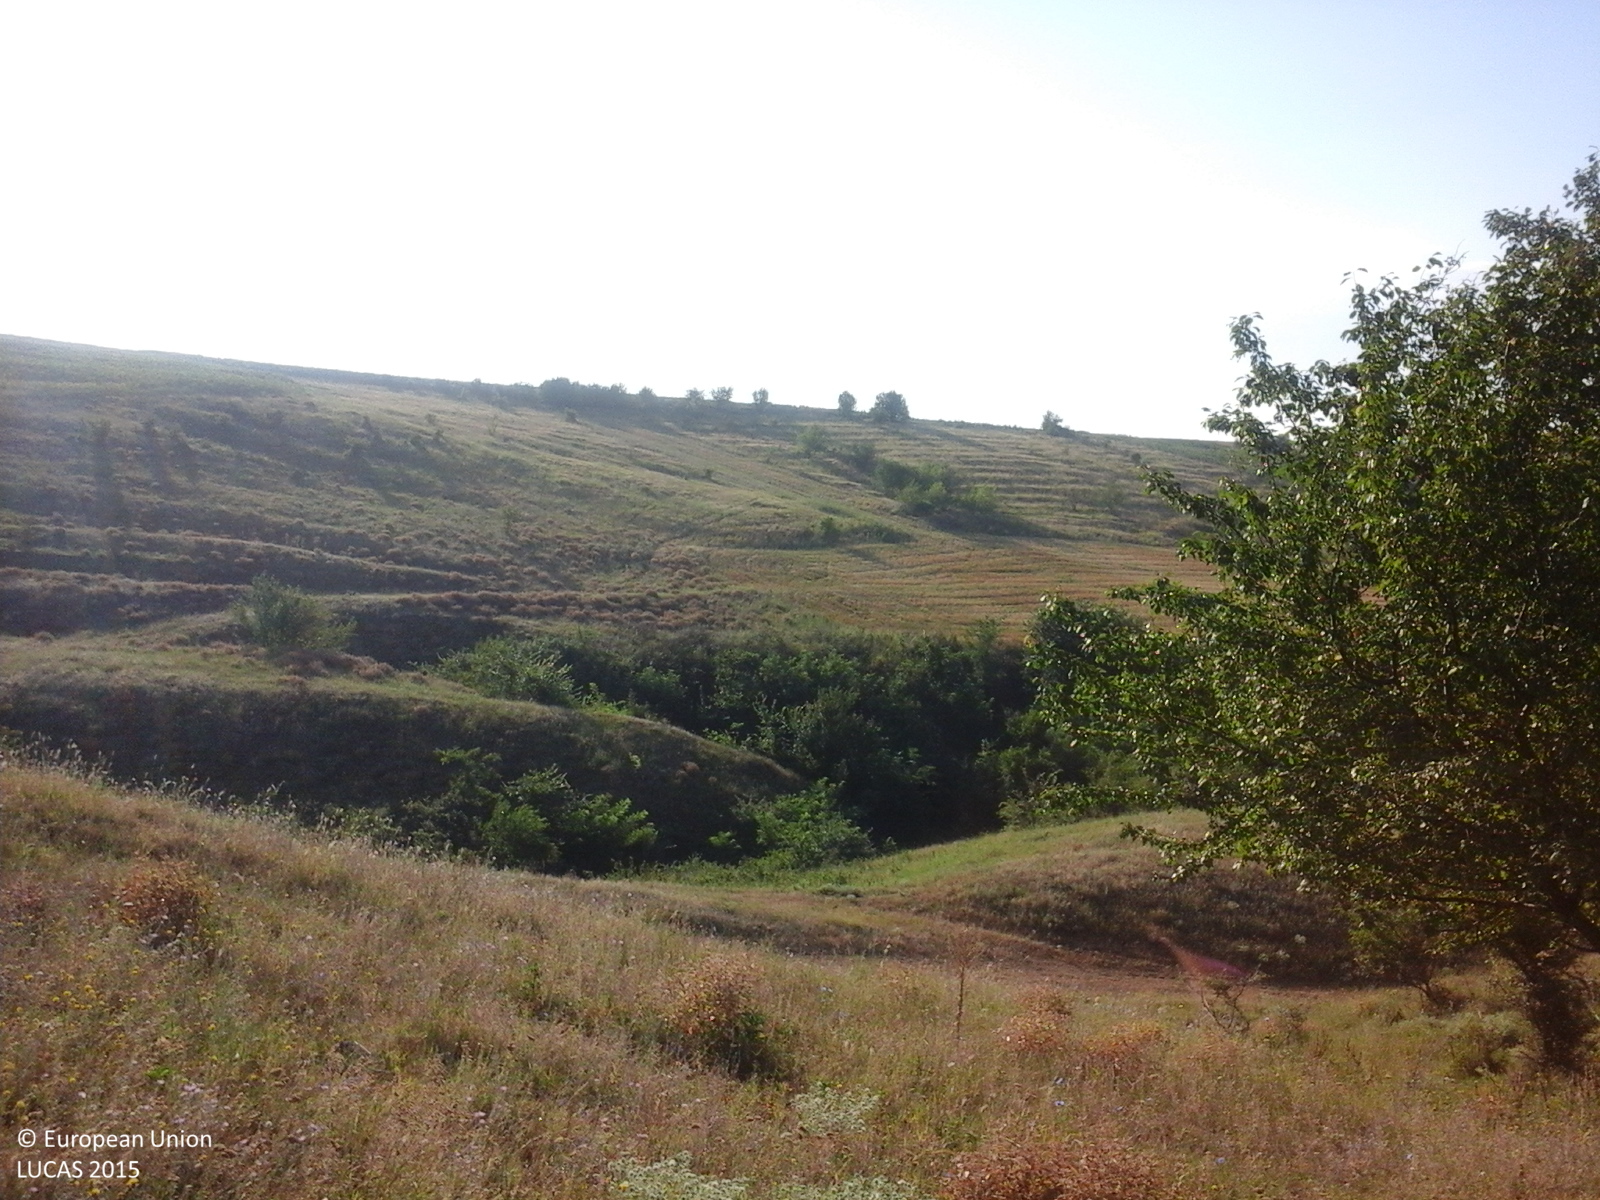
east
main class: Grassland
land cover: Grassland without tree/shrub cover
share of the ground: > 75 %
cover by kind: herbaceous plants 100 %
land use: Agriculture (excluding fallow land and kitchen gardens)
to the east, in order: Grassland without tree/shrub cover; Single bushes/trees; Grassland without tree/shrub cover; Tracks; Grassland without tree/shrub cover; Broadleaved woodland; Grassland with sparse tree/shrub cover; Single bushes/trees; Grassland with sparse tree/shrub cover; Grassland without tree/shrub cover
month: July
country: RO
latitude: 46.2176
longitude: 27.7328
